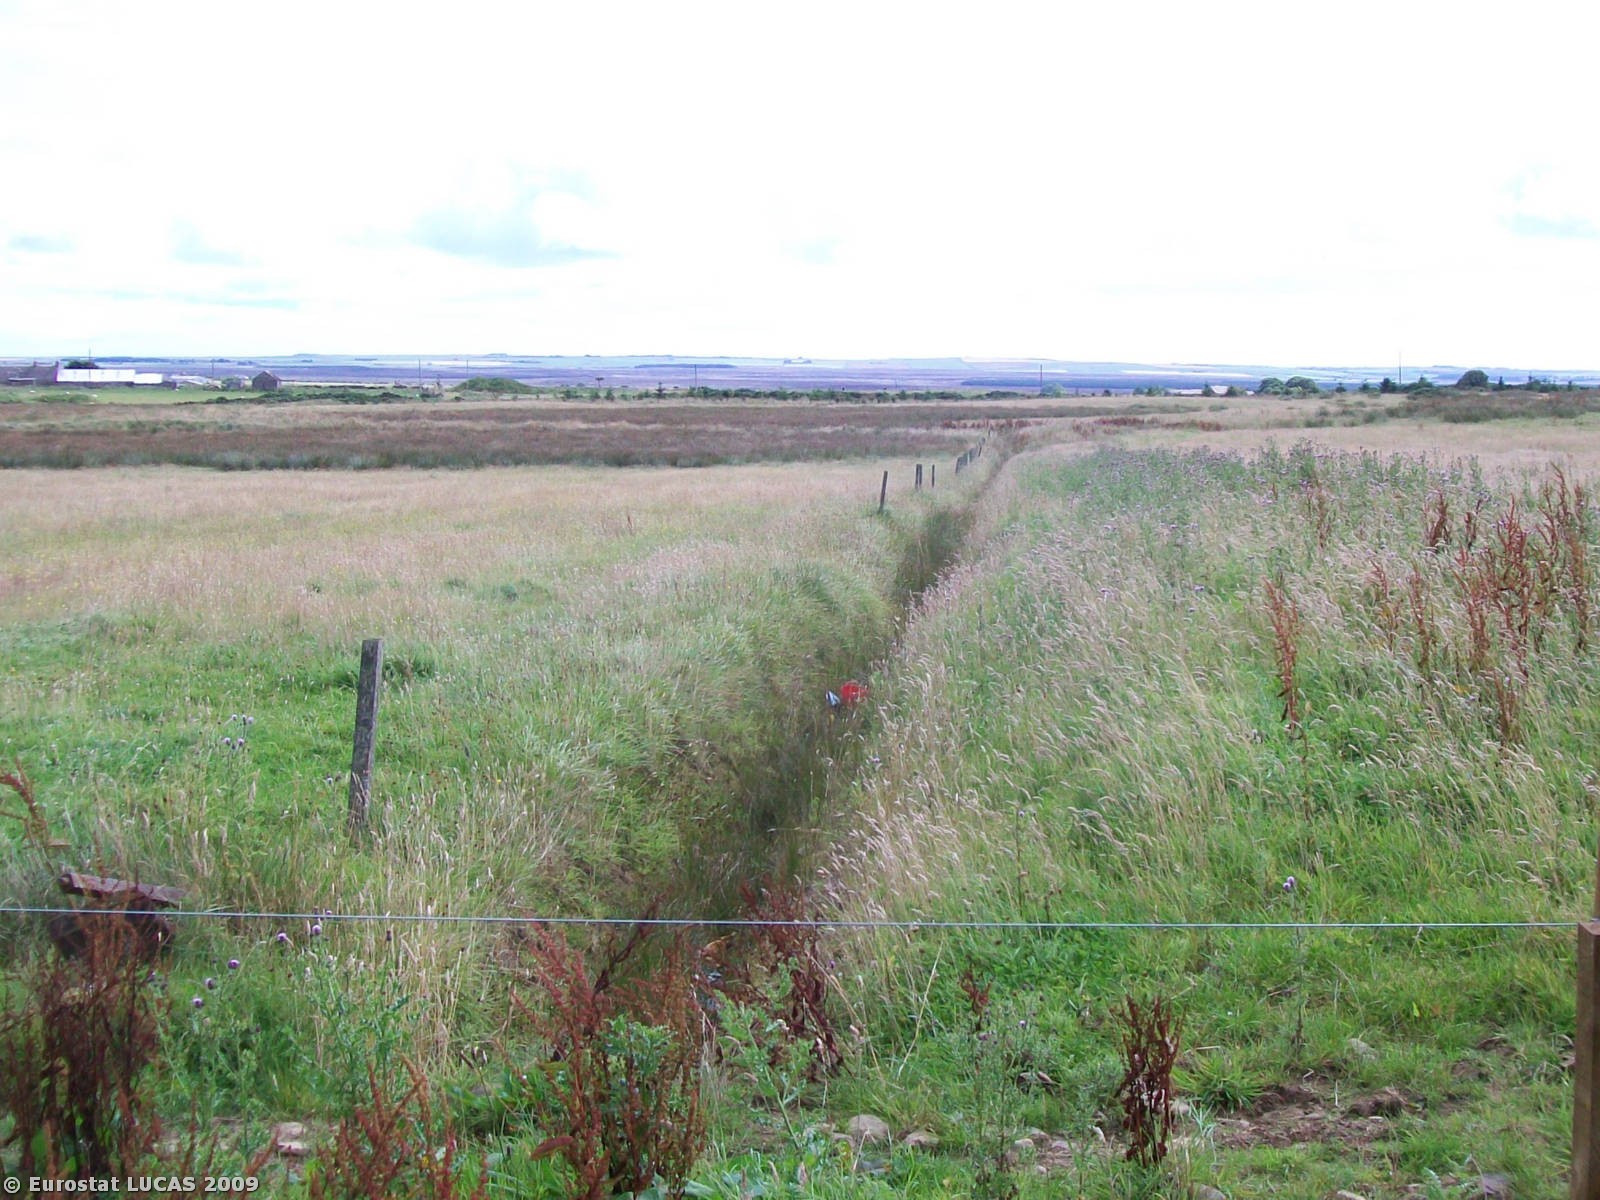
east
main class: Cropland
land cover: Temporary grasslands
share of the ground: > 75 %
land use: Agriculture (excluding fallow land and kitchen gardens)
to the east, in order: Temporary grasslands; Ditches and canals; Fences; Temporary grasslands; Grassland without tree/shrub cover
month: August
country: GB
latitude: 58.5055
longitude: -3.2926
